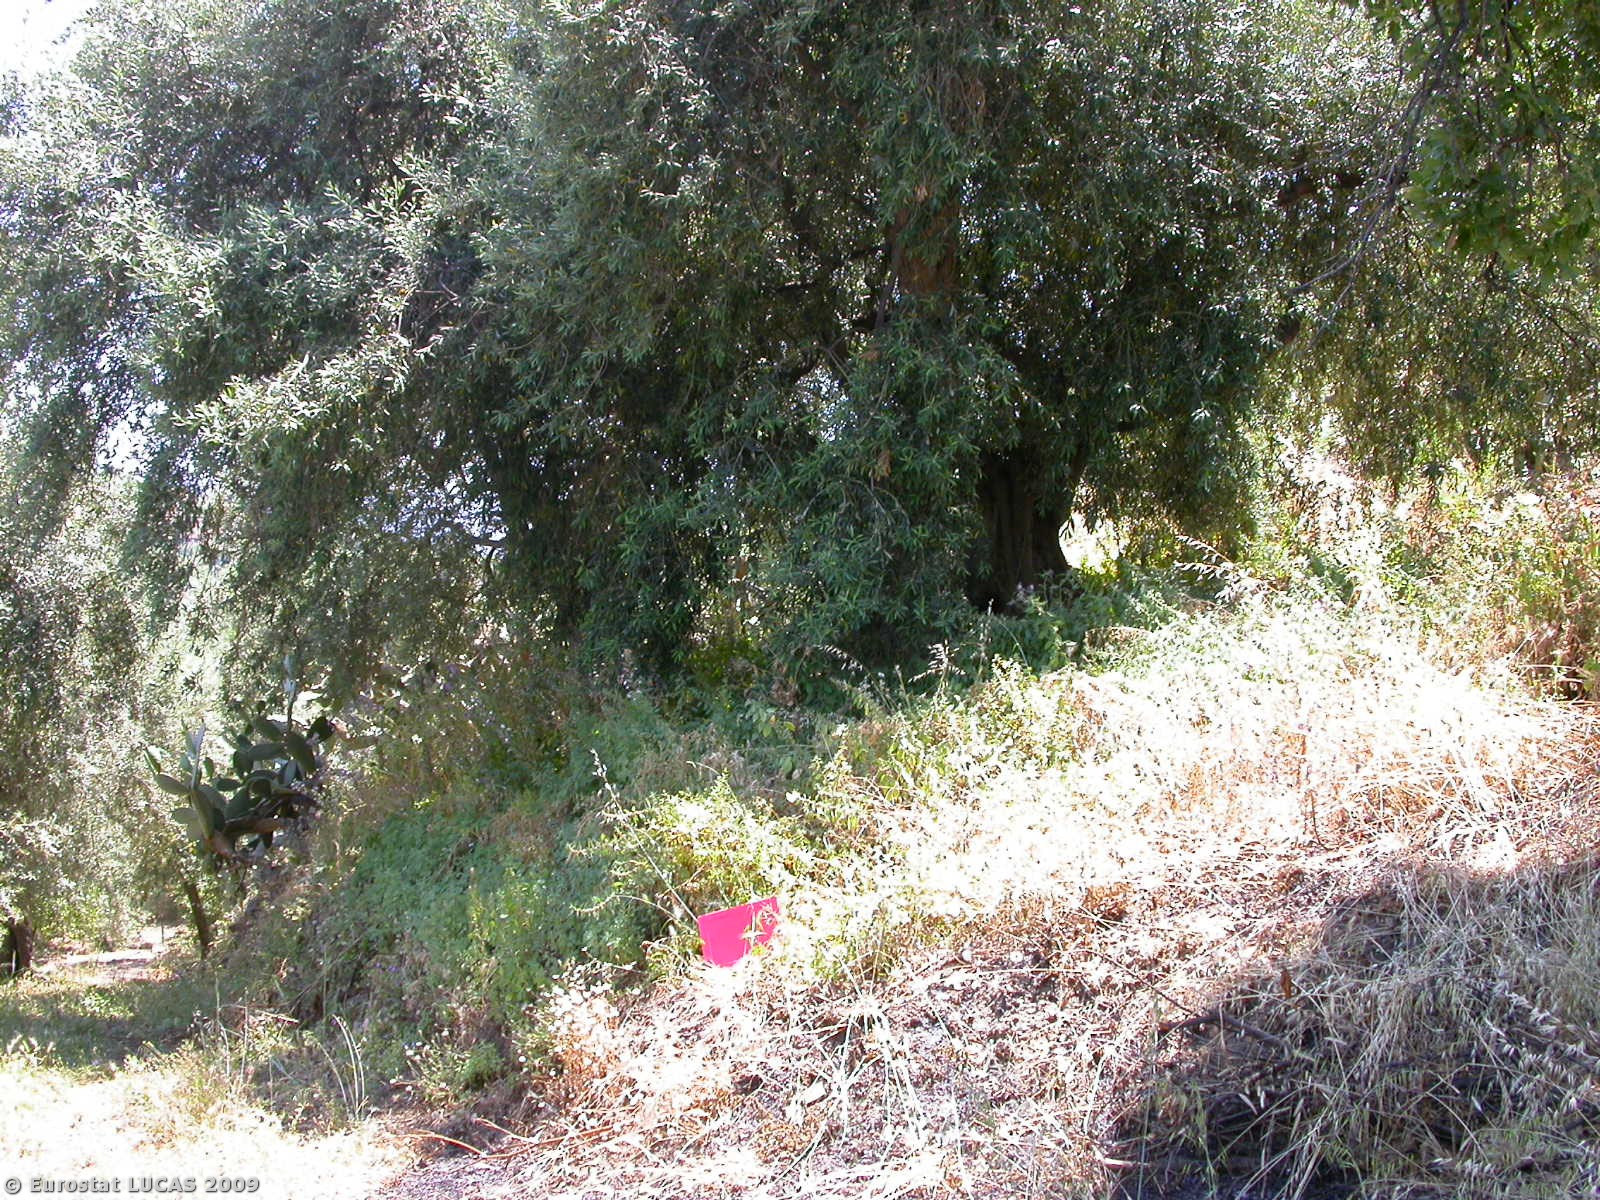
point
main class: Cropland
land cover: Olive groves
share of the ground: 50 - 75 %
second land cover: Spontaneously vegetated surfaces
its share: 50 - 75 %
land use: Agriculture (excluding fallow land and kitchen gardens)
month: June
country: IT
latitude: 38.1274
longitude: 14.9527
